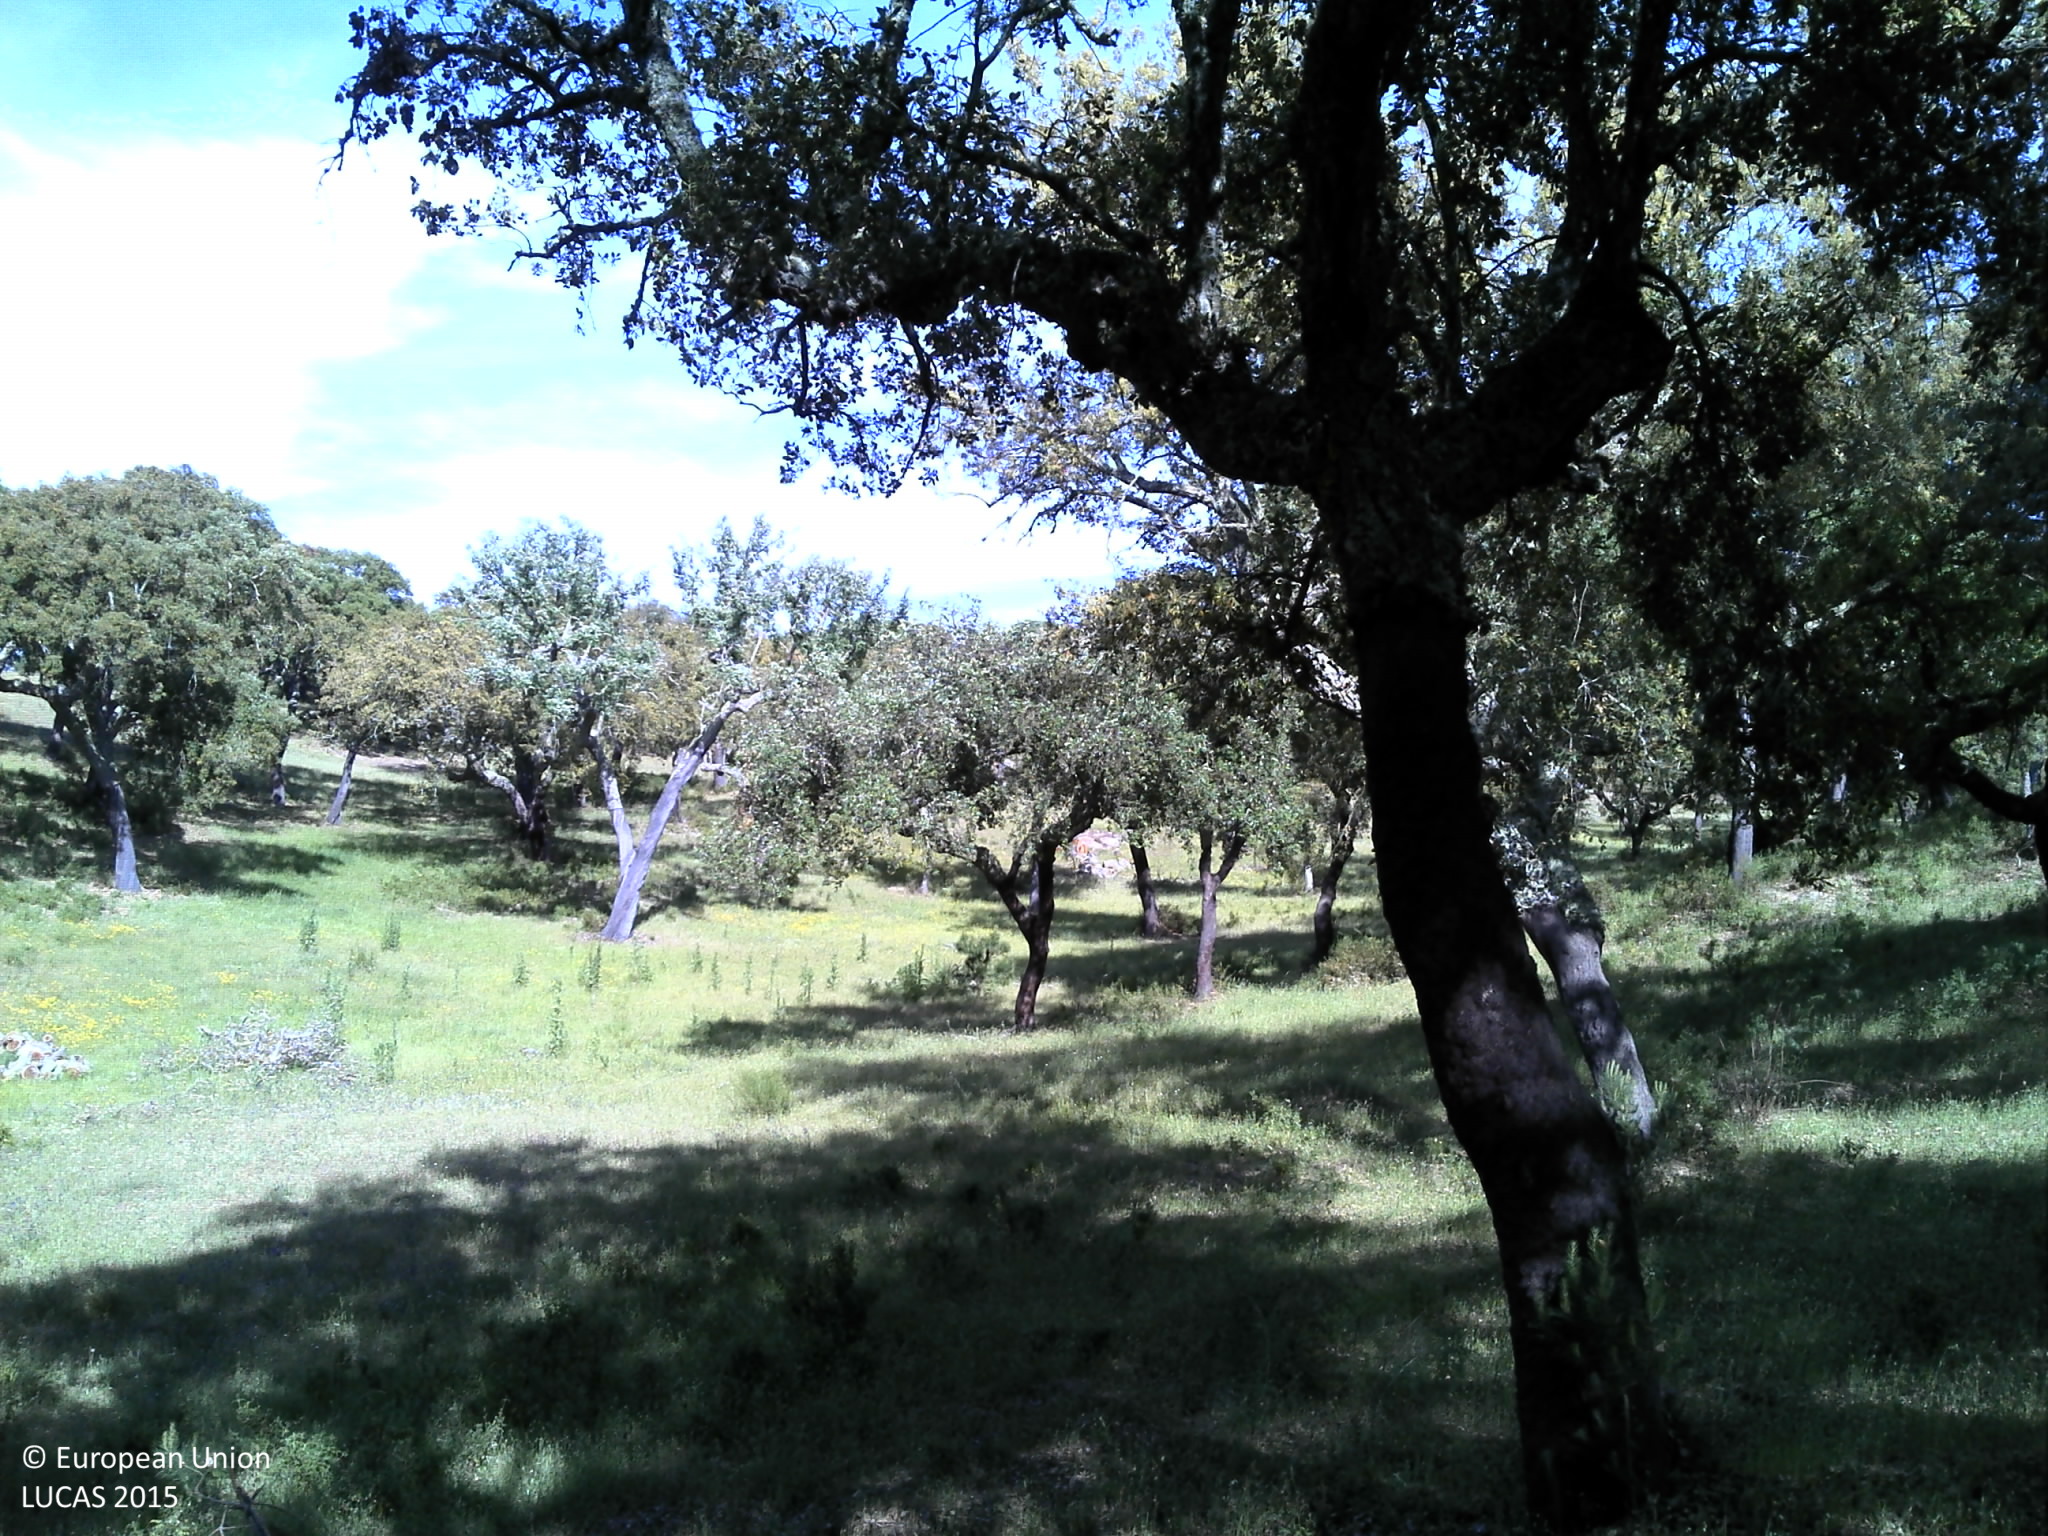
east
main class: Woodland
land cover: Broadleaved woodland
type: broadleaved evergreen forest
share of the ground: 50 - 75 %
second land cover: Grassland without tree/shrub cover
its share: 10 - 25 %
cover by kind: broadleaved forest trees 75 %, herbaceous plants 15 %, unconsolidated bare surface 10 %
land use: Forestry
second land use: Agriculture (excluding fallow land and kitchen gardens)
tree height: > 5 m
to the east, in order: Broadleaved woodland; Grassland without tree/shrub cover; Tracks; Broadleaved woodland
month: May
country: PT
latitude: 38.9806
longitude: -8.1656
